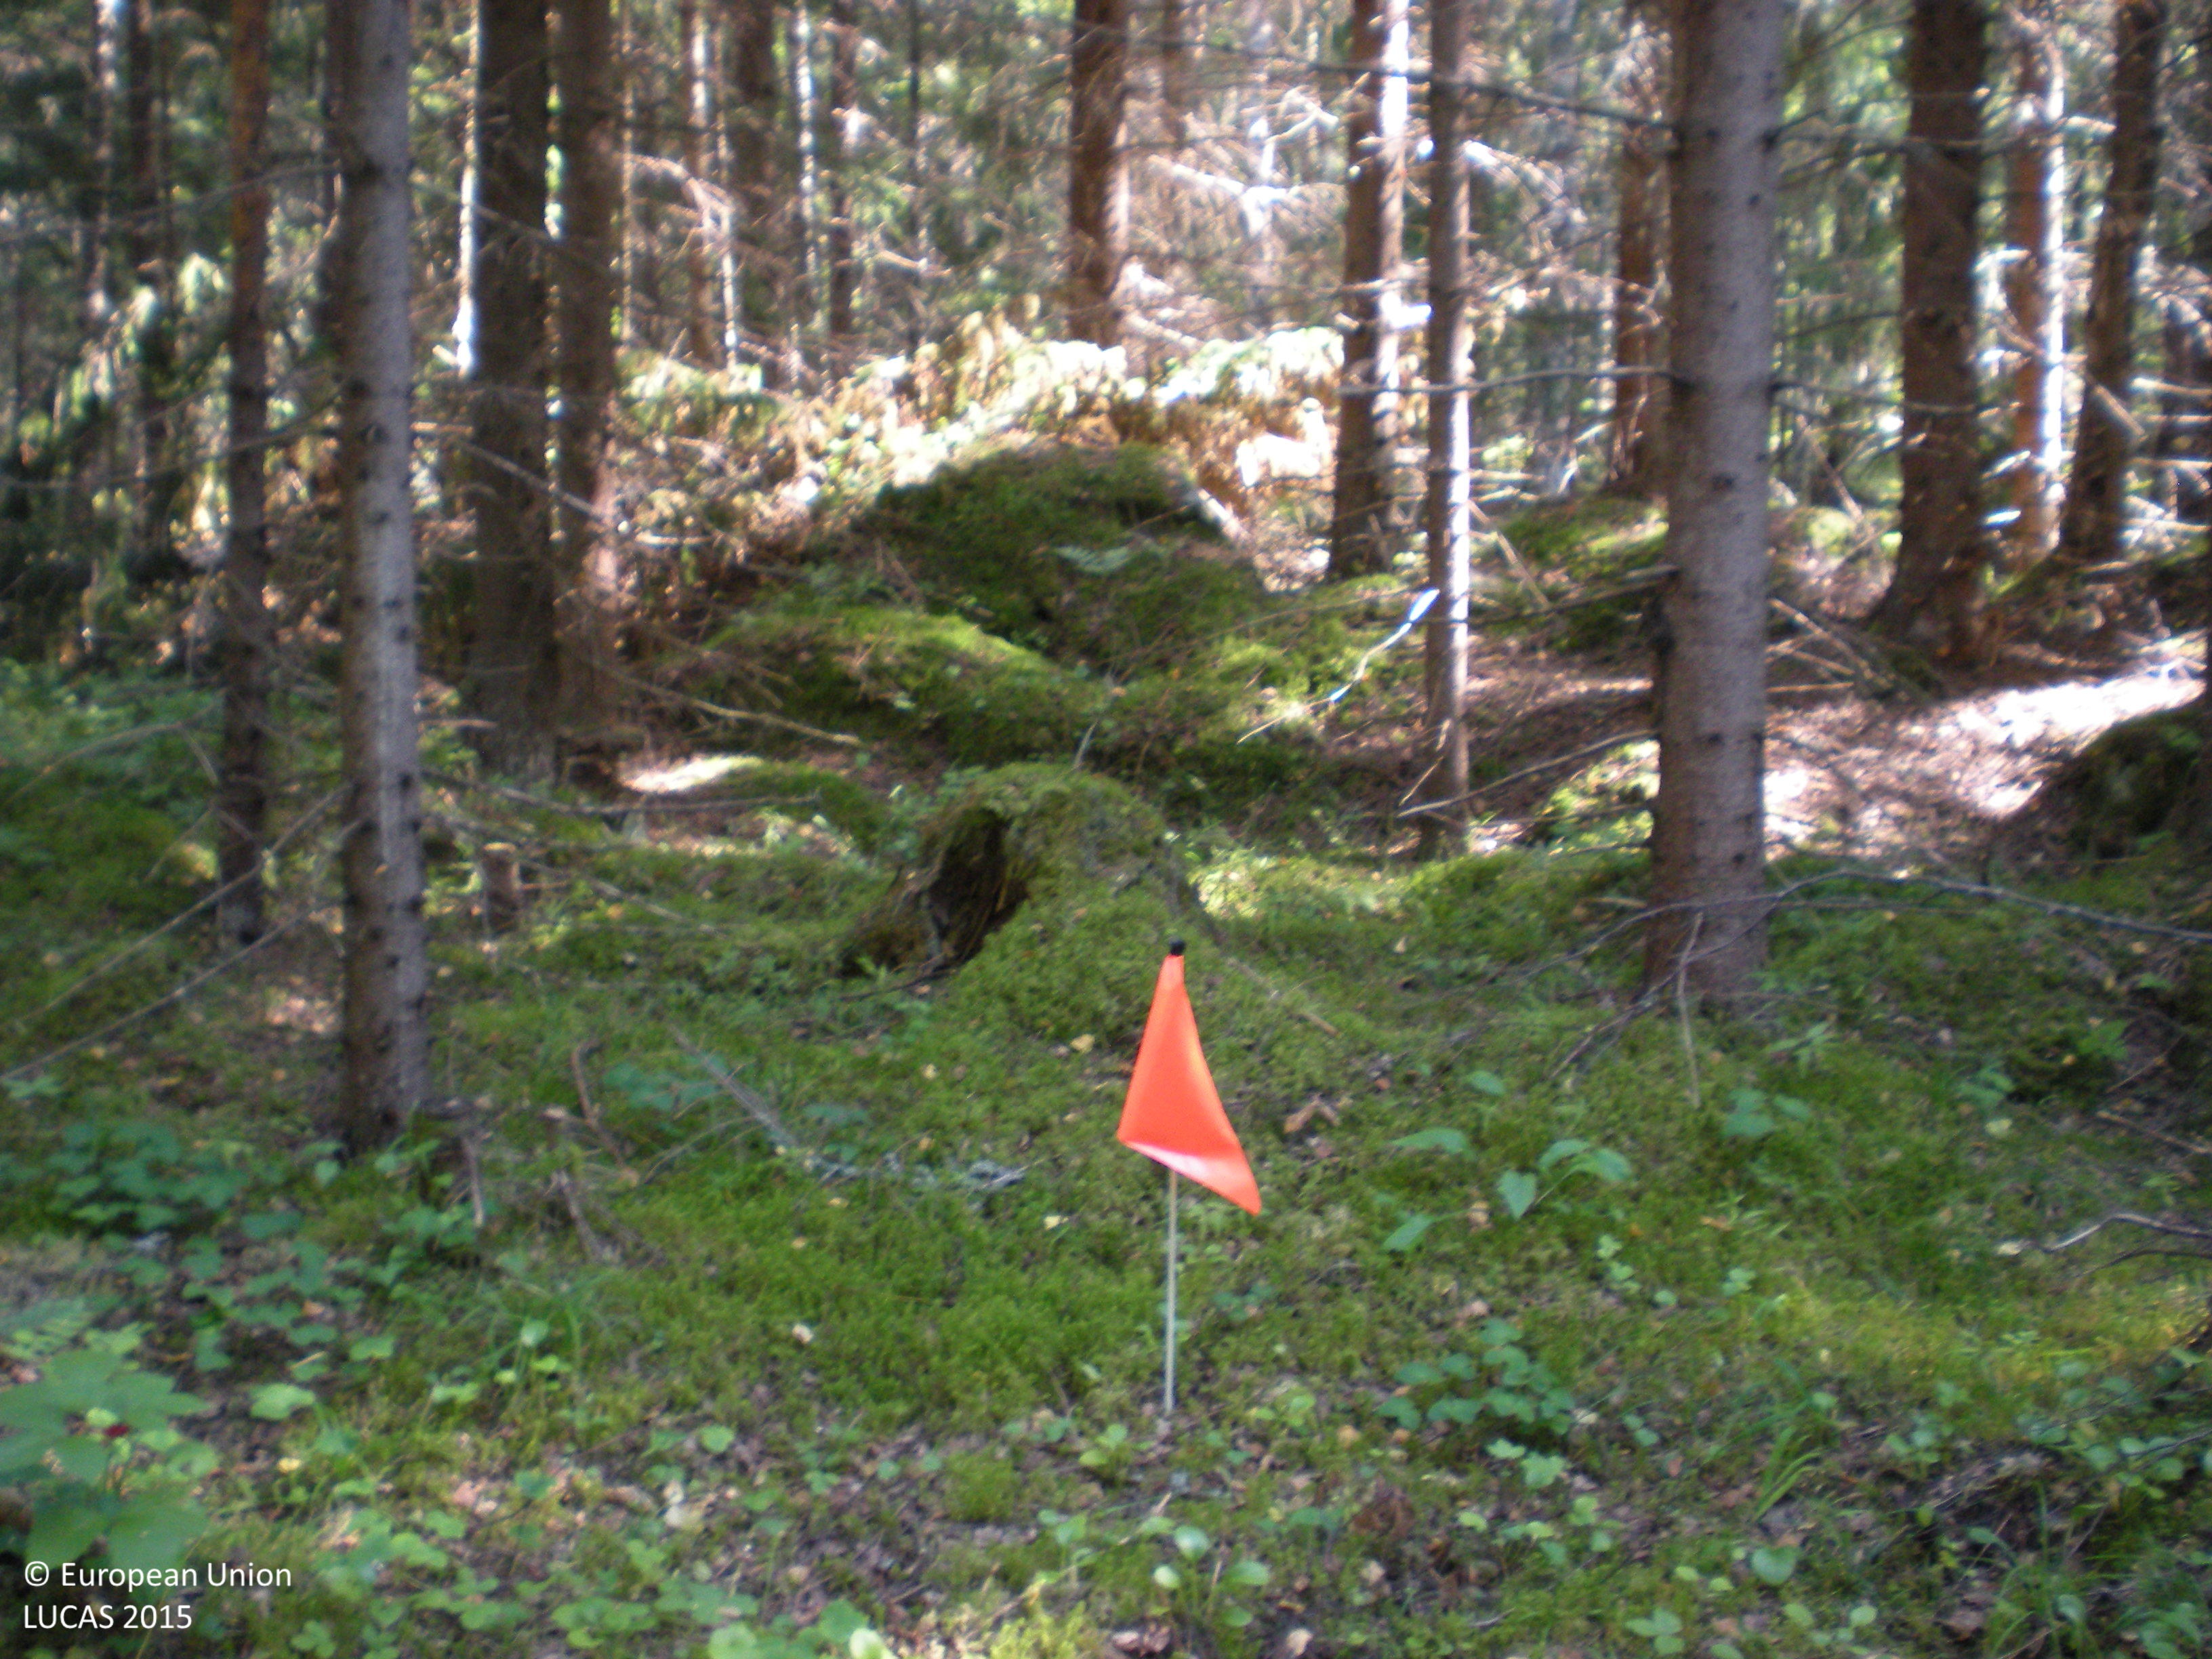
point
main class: Woodland
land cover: Spruce dominated coniferous woodland
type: boreal forest
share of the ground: > 75 %
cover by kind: coniferous forest trees 80 %, lichens and mosses 10 %, broadleaved forest trees 5 %, shrubs 5 %
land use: Forestry
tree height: > 5 m
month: August
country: SE
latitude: 60.6246
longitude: 17.6483
